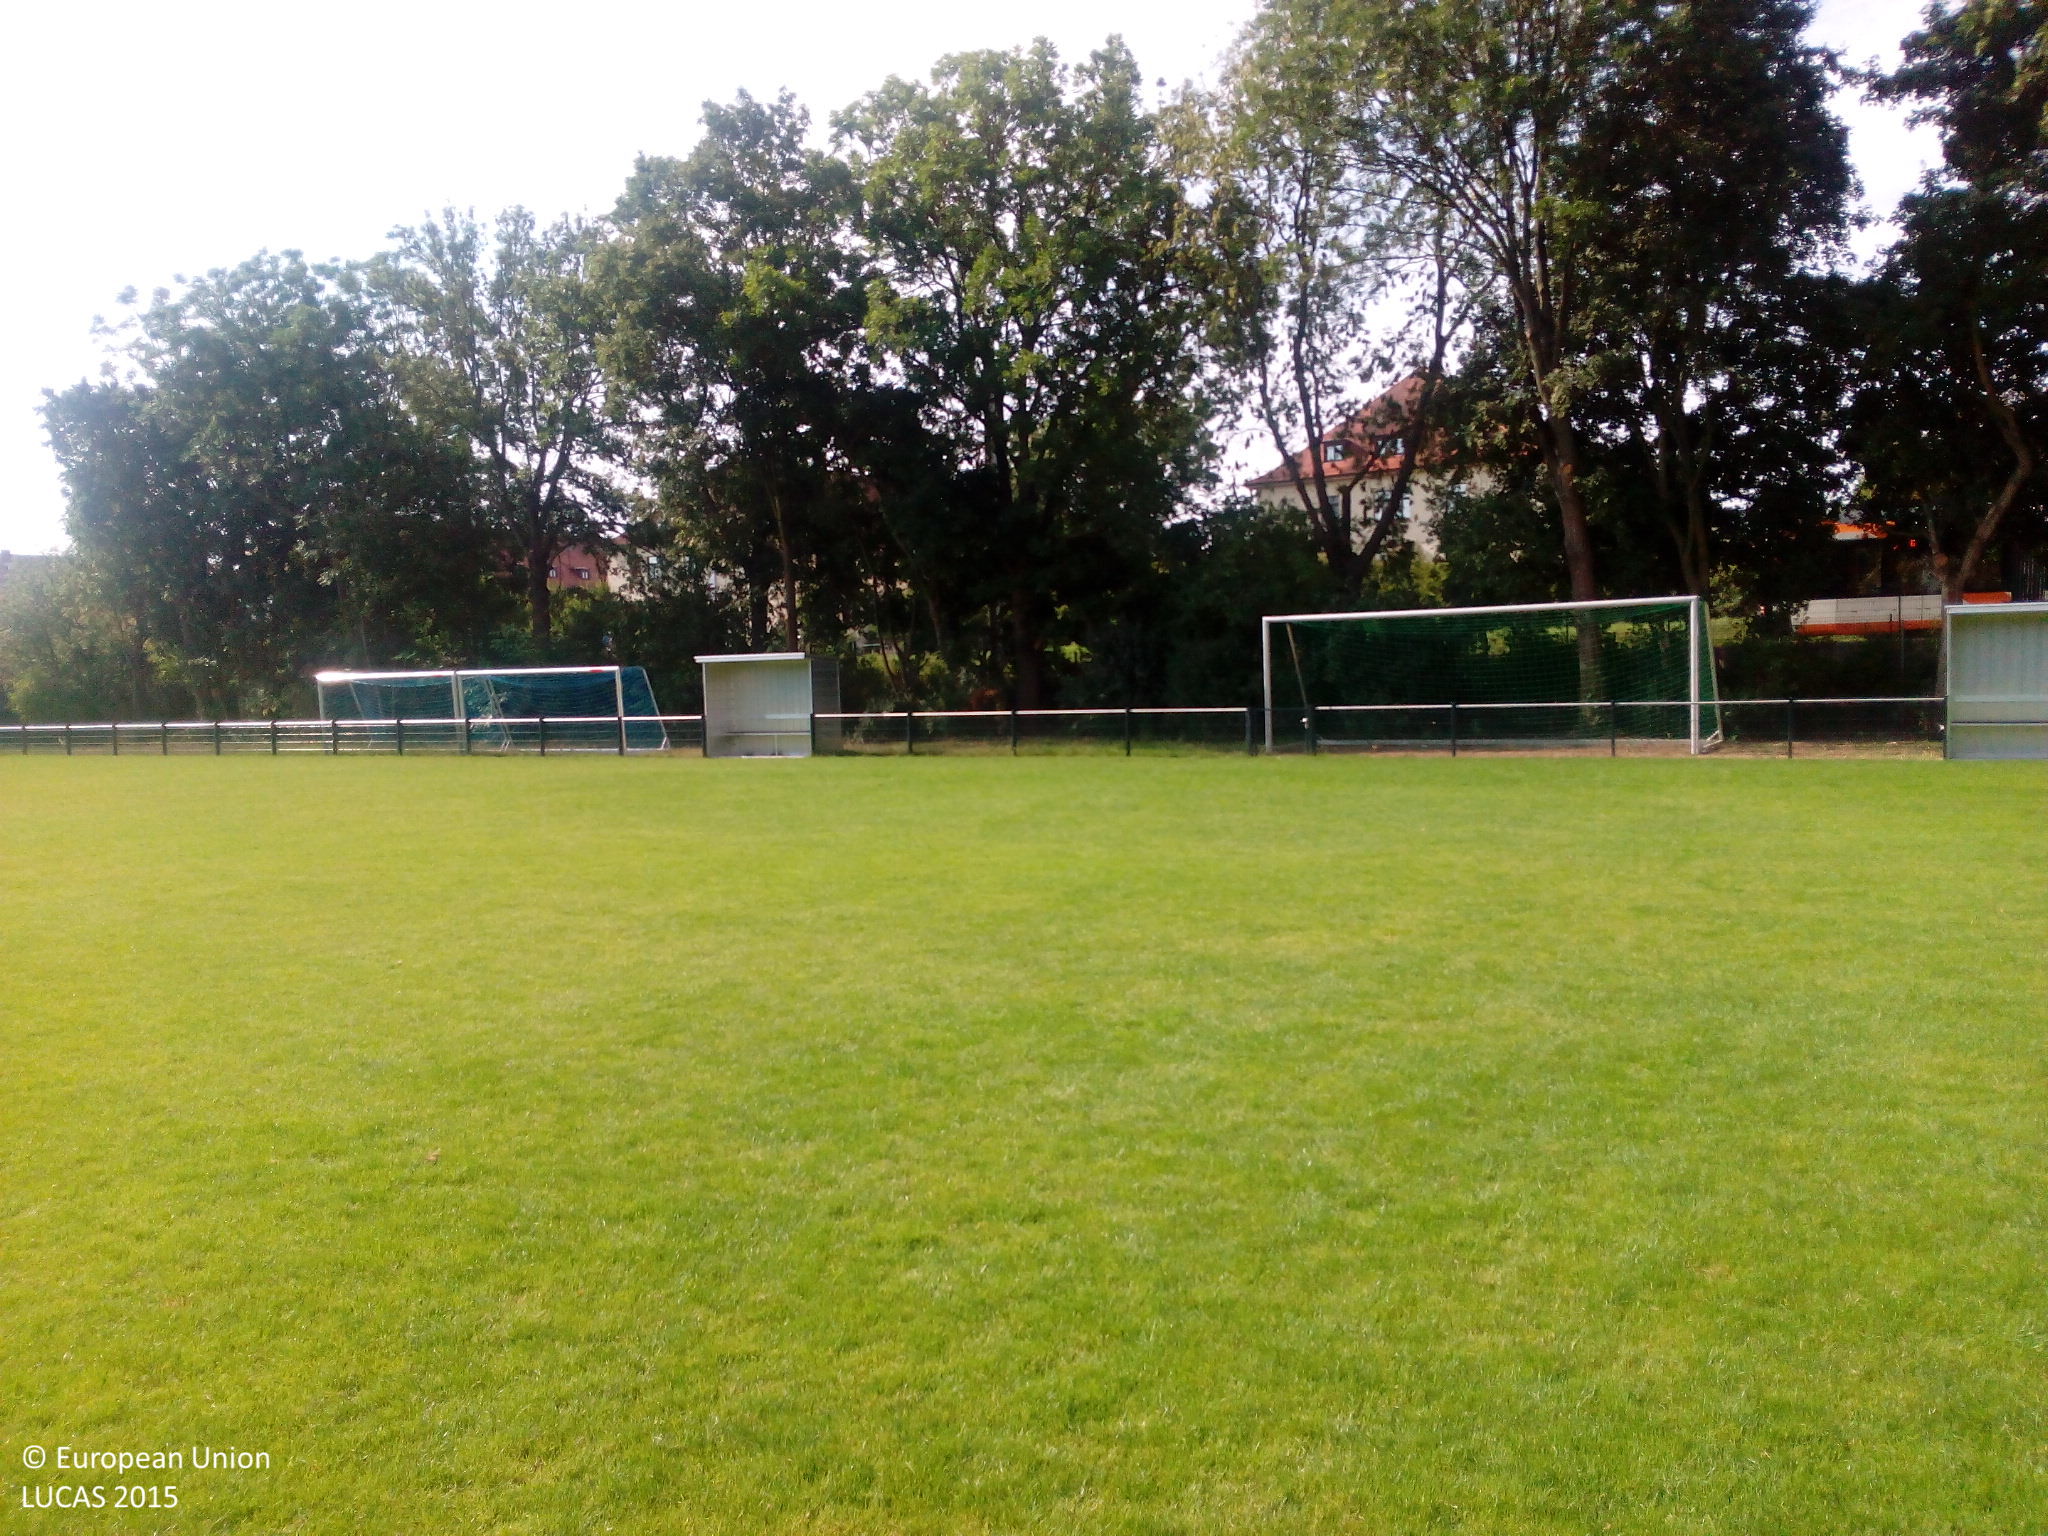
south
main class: Grassland
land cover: Grassland without tree/shrub cover
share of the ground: > 75 %
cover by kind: herbaceous plants 95 %, unconsolidated bare surface 5 %
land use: Sport
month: August
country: DE
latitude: 49.4736
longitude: 8.5514
